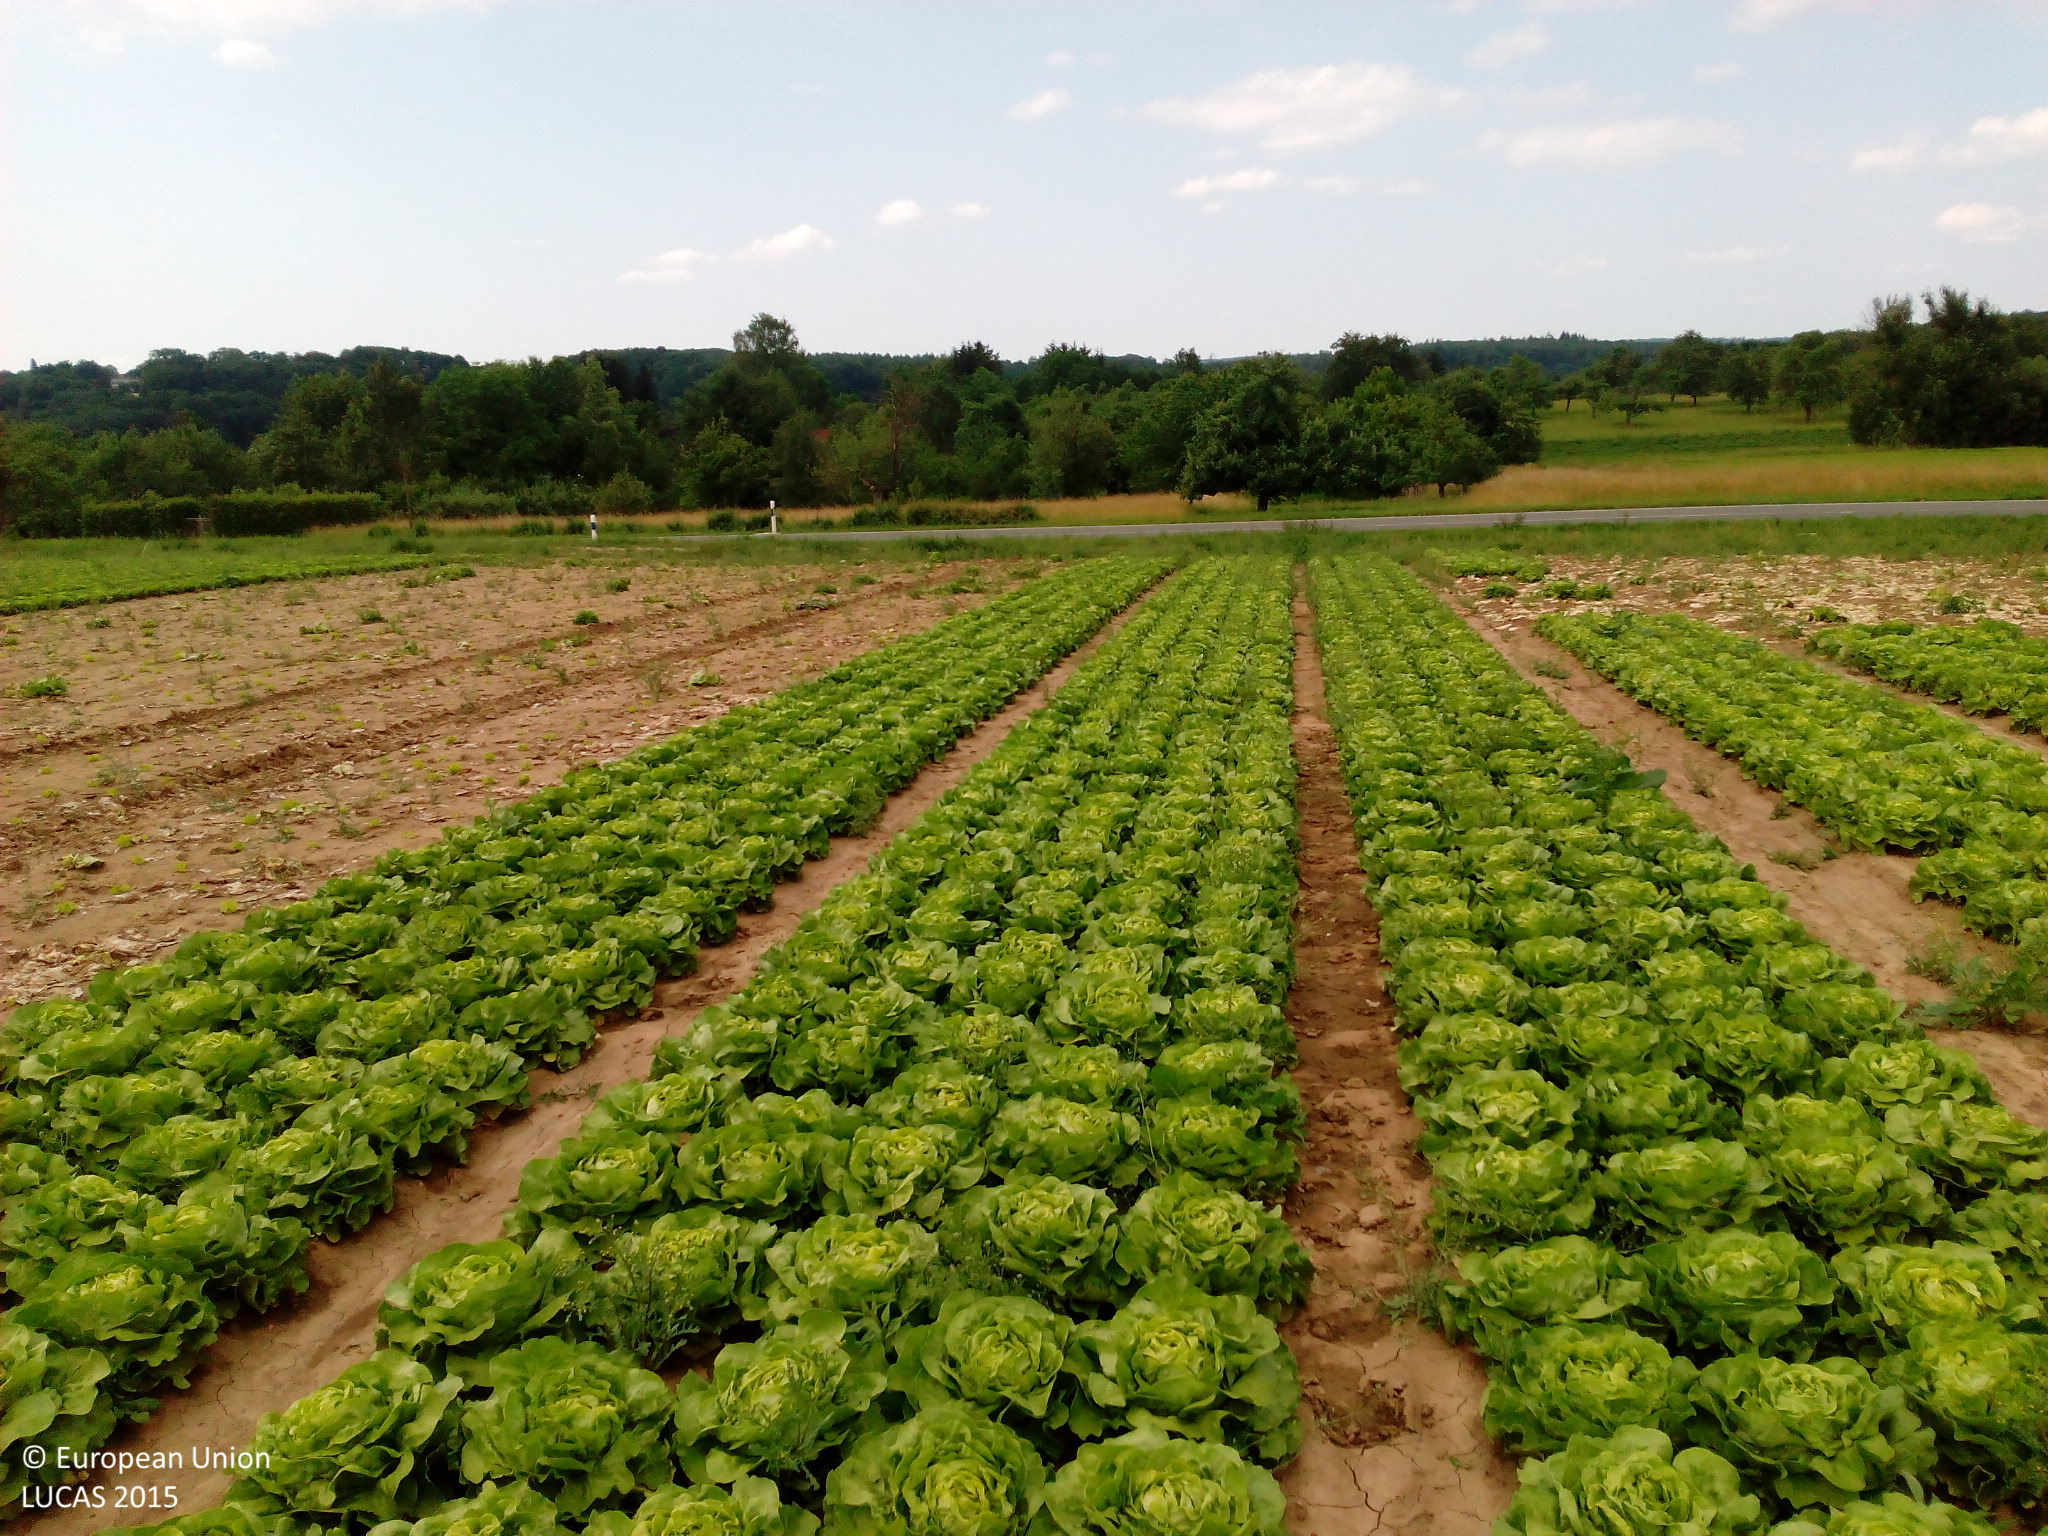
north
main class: Cropland
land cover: Other fresh vegetables
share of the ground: > 75 %
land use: Agriculture (excluding fallow land and kitchen gardens)
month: June
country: DE
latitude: 48.6894
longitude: 9.3347
